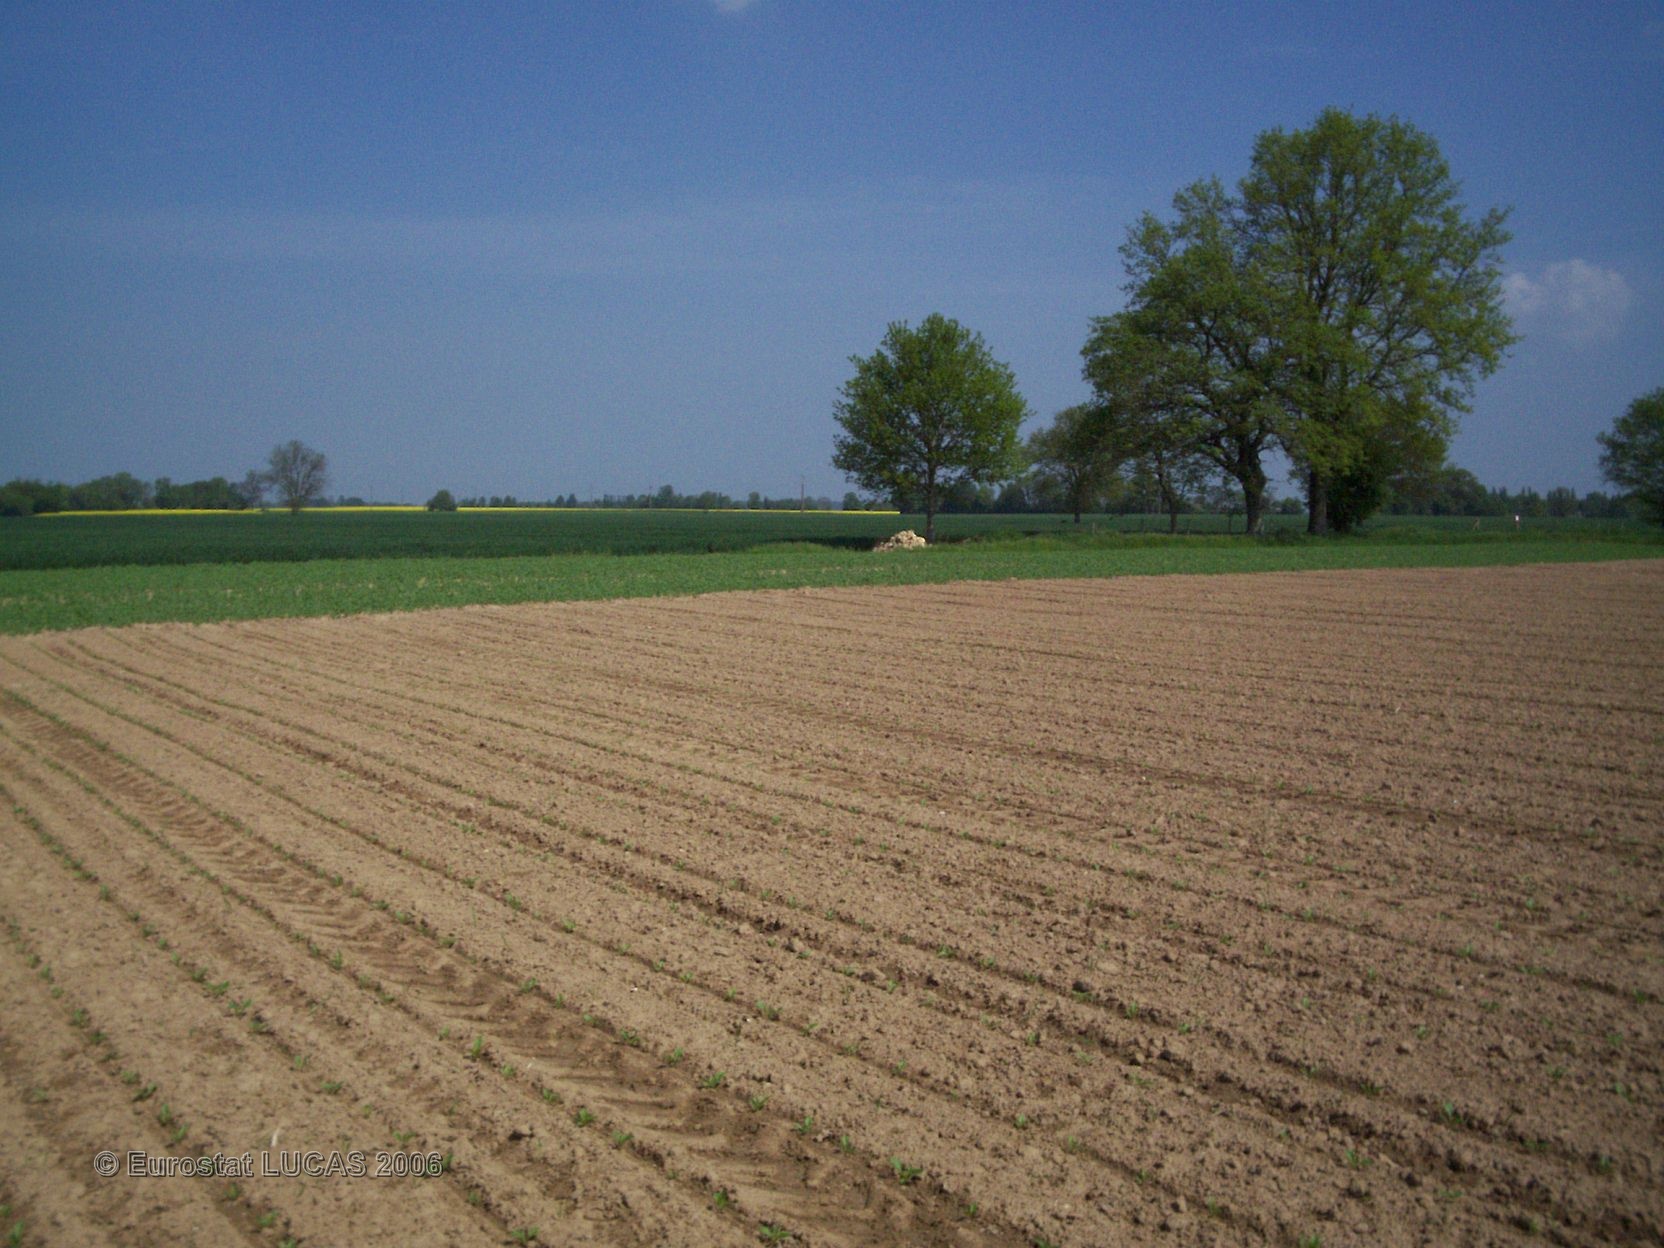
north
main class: Cropland
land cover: Sugar beet
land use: Agriculture (excluding fallow land and kitchen gardens)
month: May
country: FR
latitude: 49.1931
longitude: 0.5471
